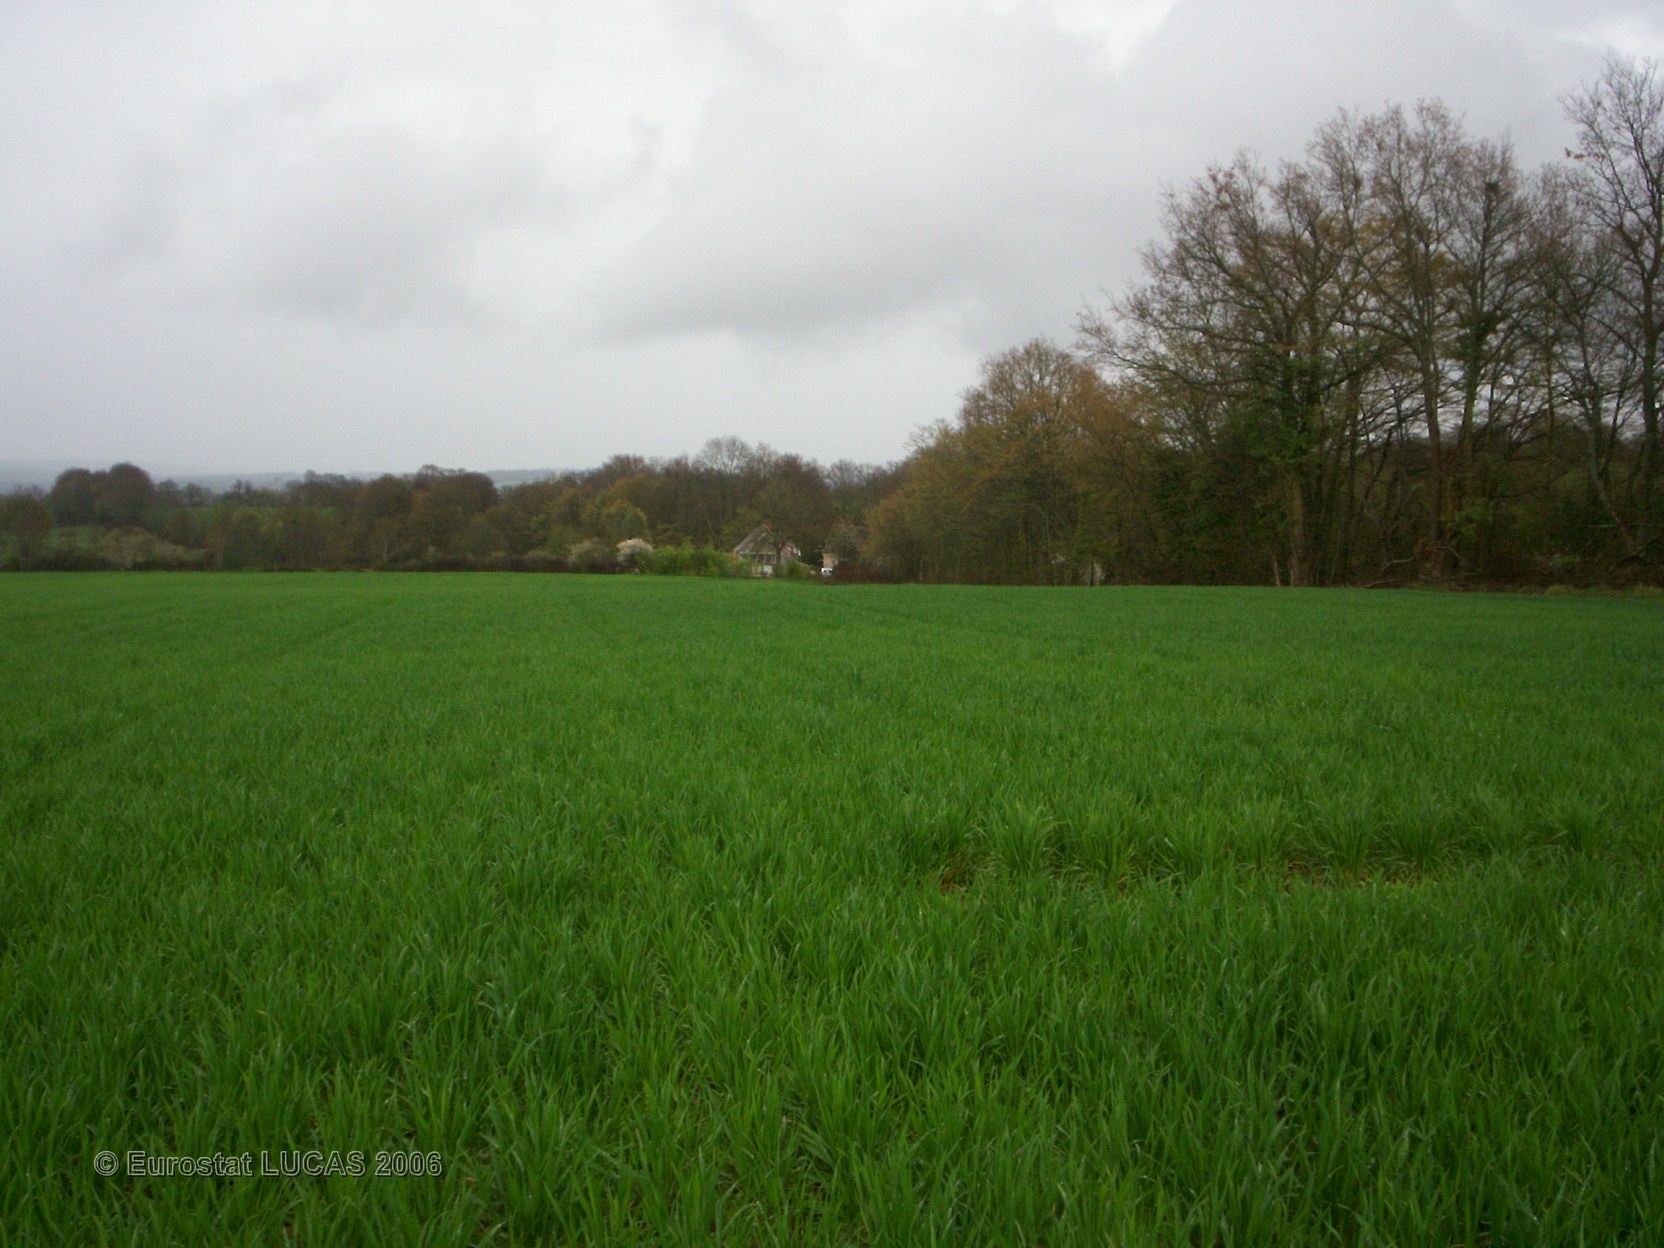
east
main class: Cropland
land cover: Barley
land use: Agriculture (excluding fallow land and kitchen gardens)
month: April
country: FR
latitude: 47.5147
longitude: 3.0229
